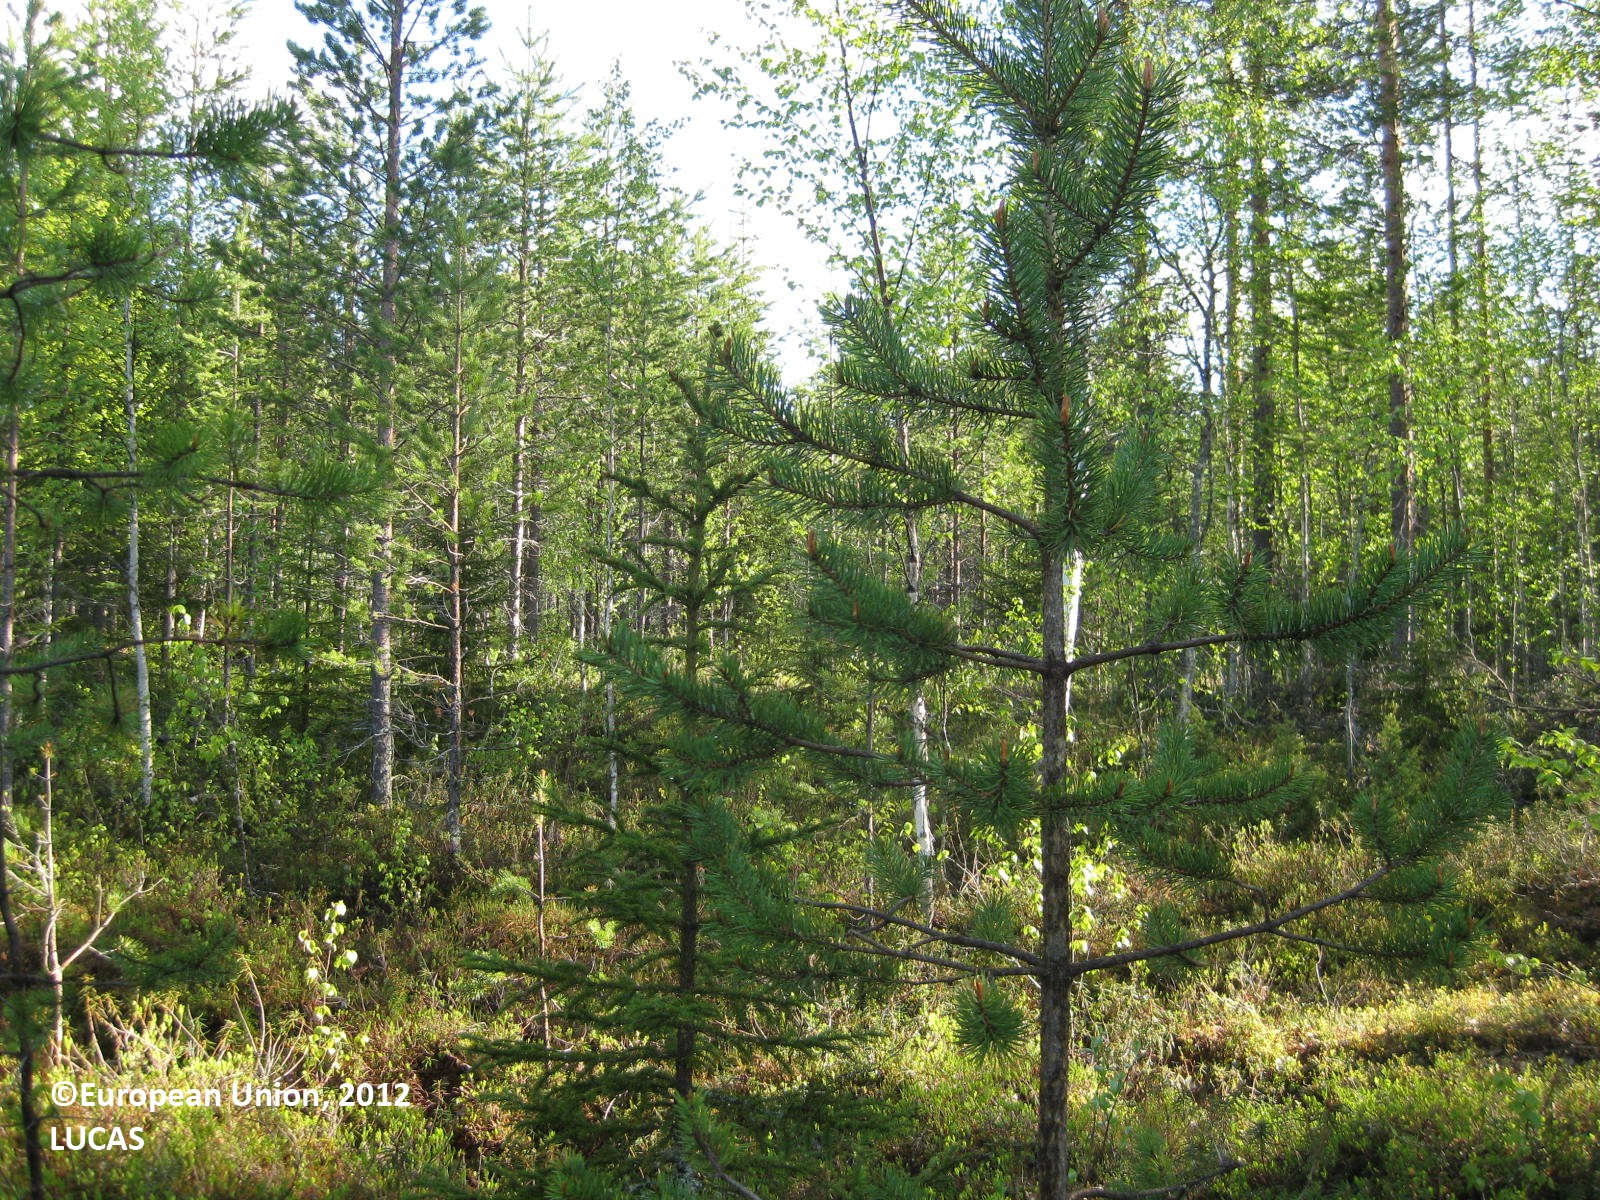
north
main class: Woodland
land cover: Pine dominated mixed woodland
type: boreal forest
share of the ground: 50 - 75 %
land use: Forestry
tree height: > 5 m
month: June
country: FI
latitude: 65.1278
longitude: 29.5766
